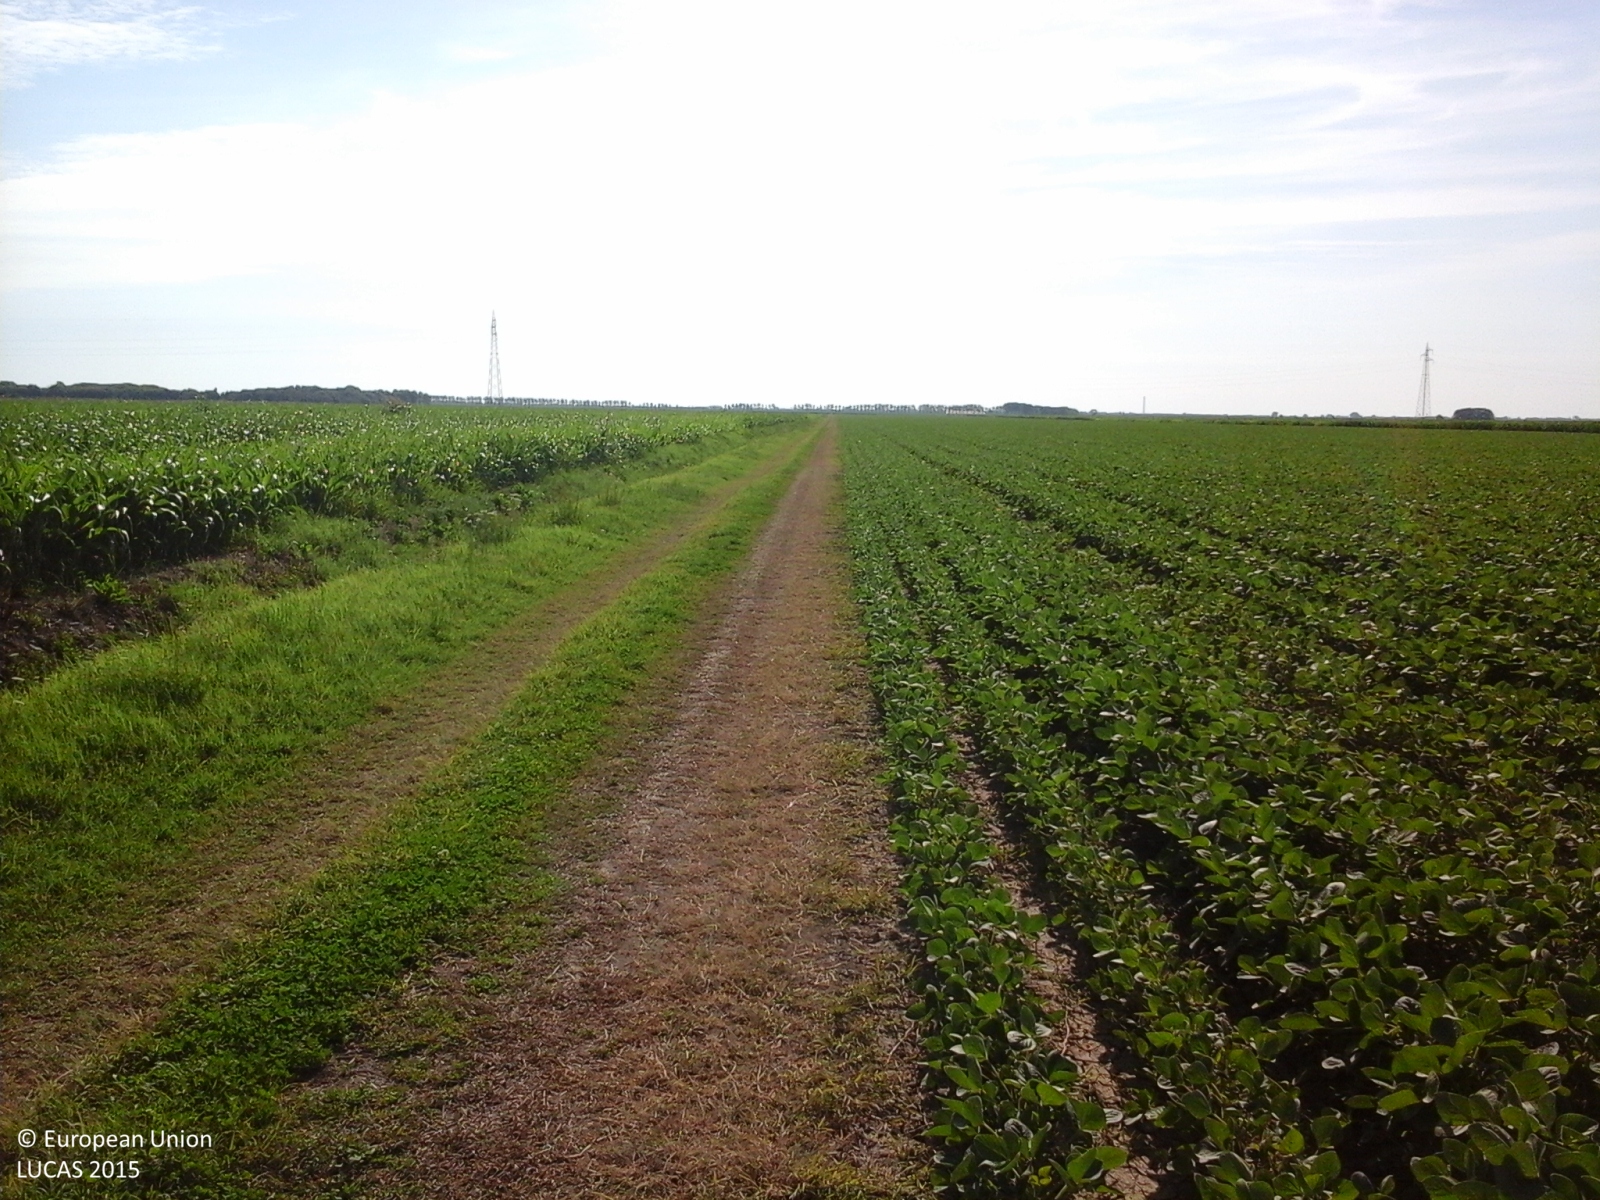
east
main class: Cropland
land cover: Soya
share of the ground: > 75 %
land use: Agriculture (excluding fallow land and kitchen gardens)
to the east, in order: Soya
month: June
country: IT
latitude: 44.9933
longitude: 12.2664
